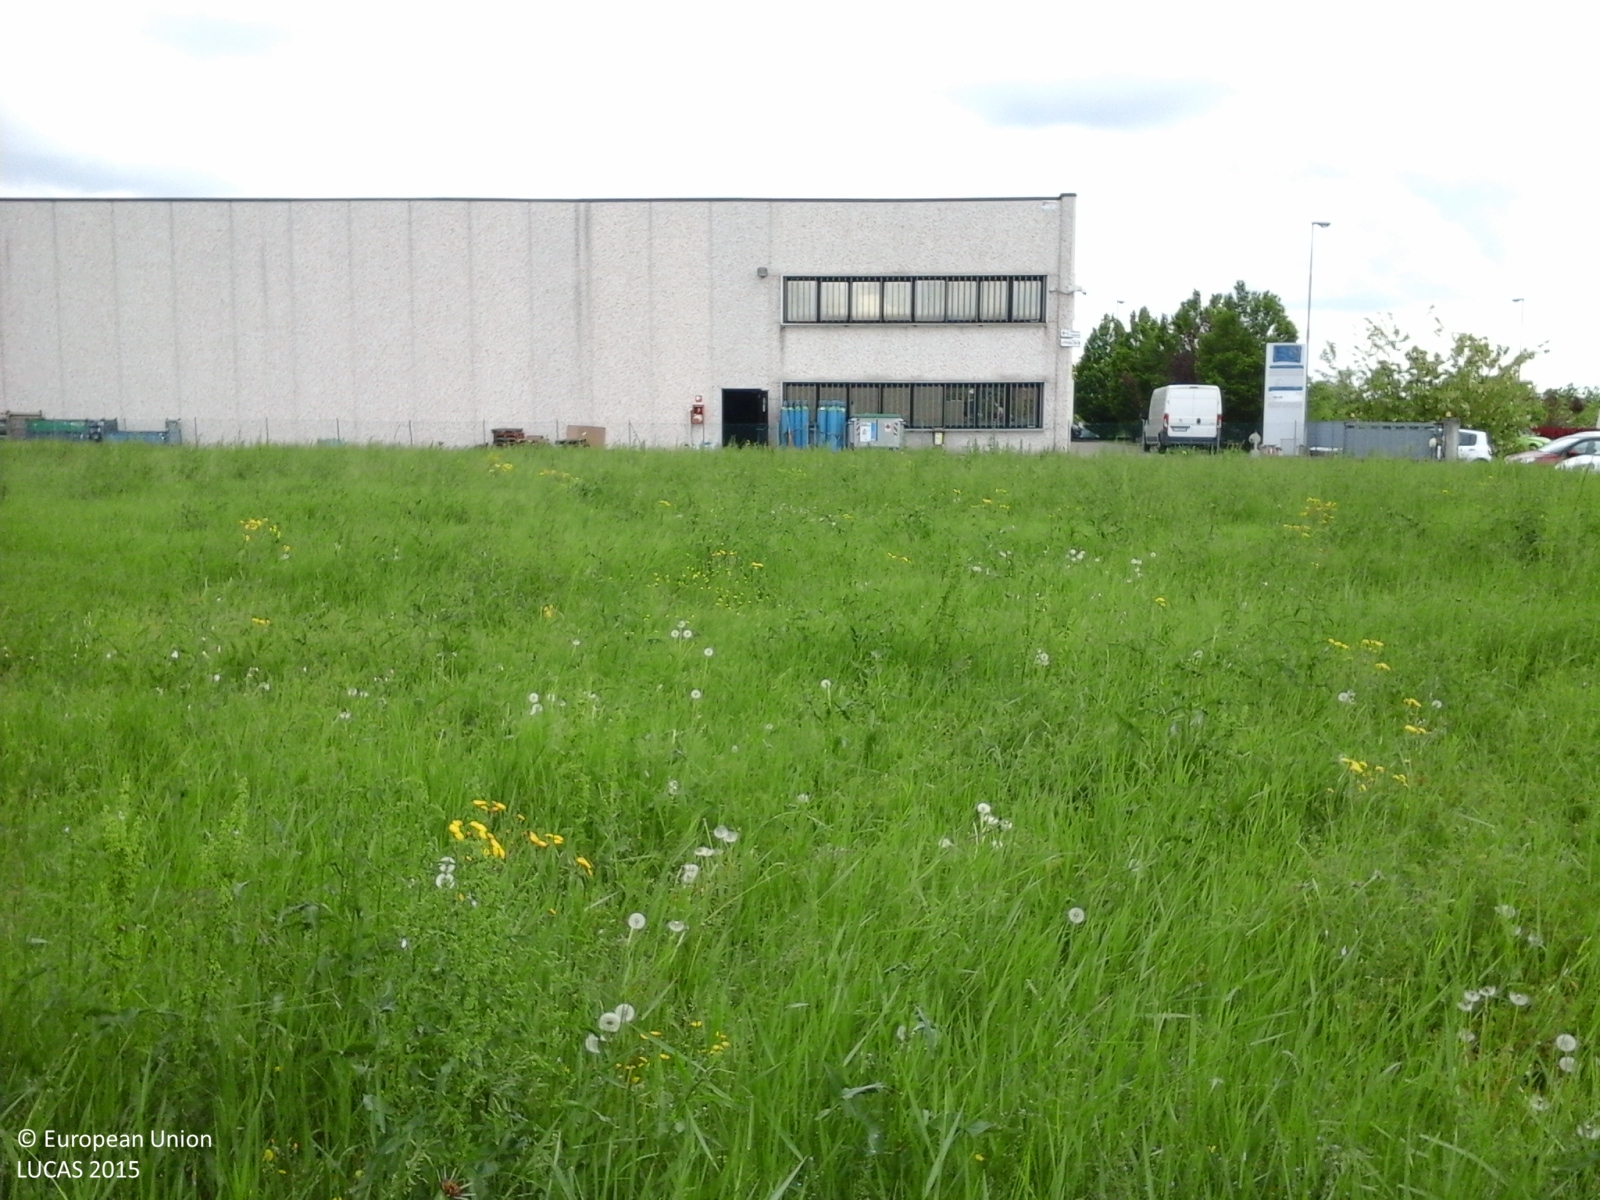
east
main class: Grassland
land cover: Grassland without tree/shrub cover
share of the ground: > 75 %
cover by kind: herbaceous plants 100 %
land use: Semi-natural and natural areas not in use
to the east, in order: Grassland without tree/shrub cover; Artificial constructions in urban areas; Grassland with sparse tree/shrub cover; Broadleaved woodland; Grassland with sparse tree/shrub cover
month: April
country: IT
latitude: 44.8701
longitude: 10.8463
